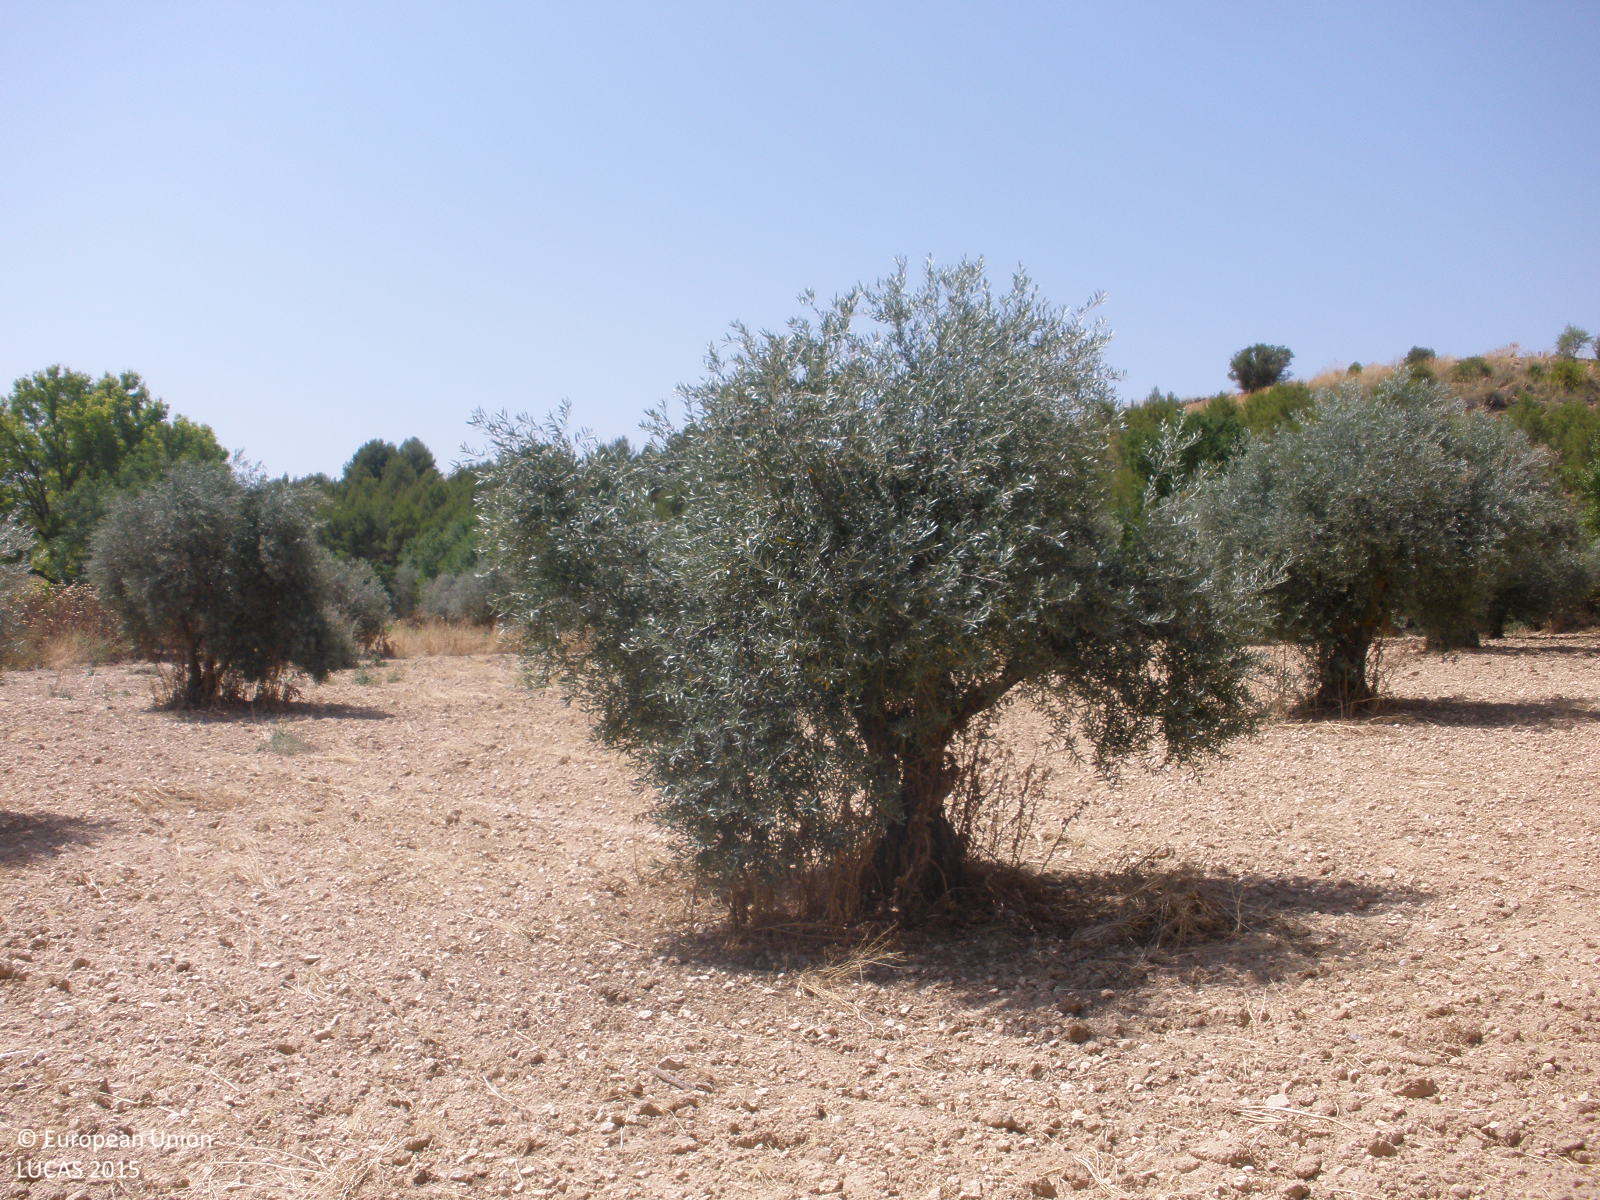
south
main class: Cropland
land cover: Olive groves
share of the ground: 25 - 50 %
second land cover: Other bare soil
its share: > 75 %
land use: Agriculture (excluding fallow land and kitchen gardens)
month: July
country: ES
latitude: 39.9909
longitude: -3.4859
